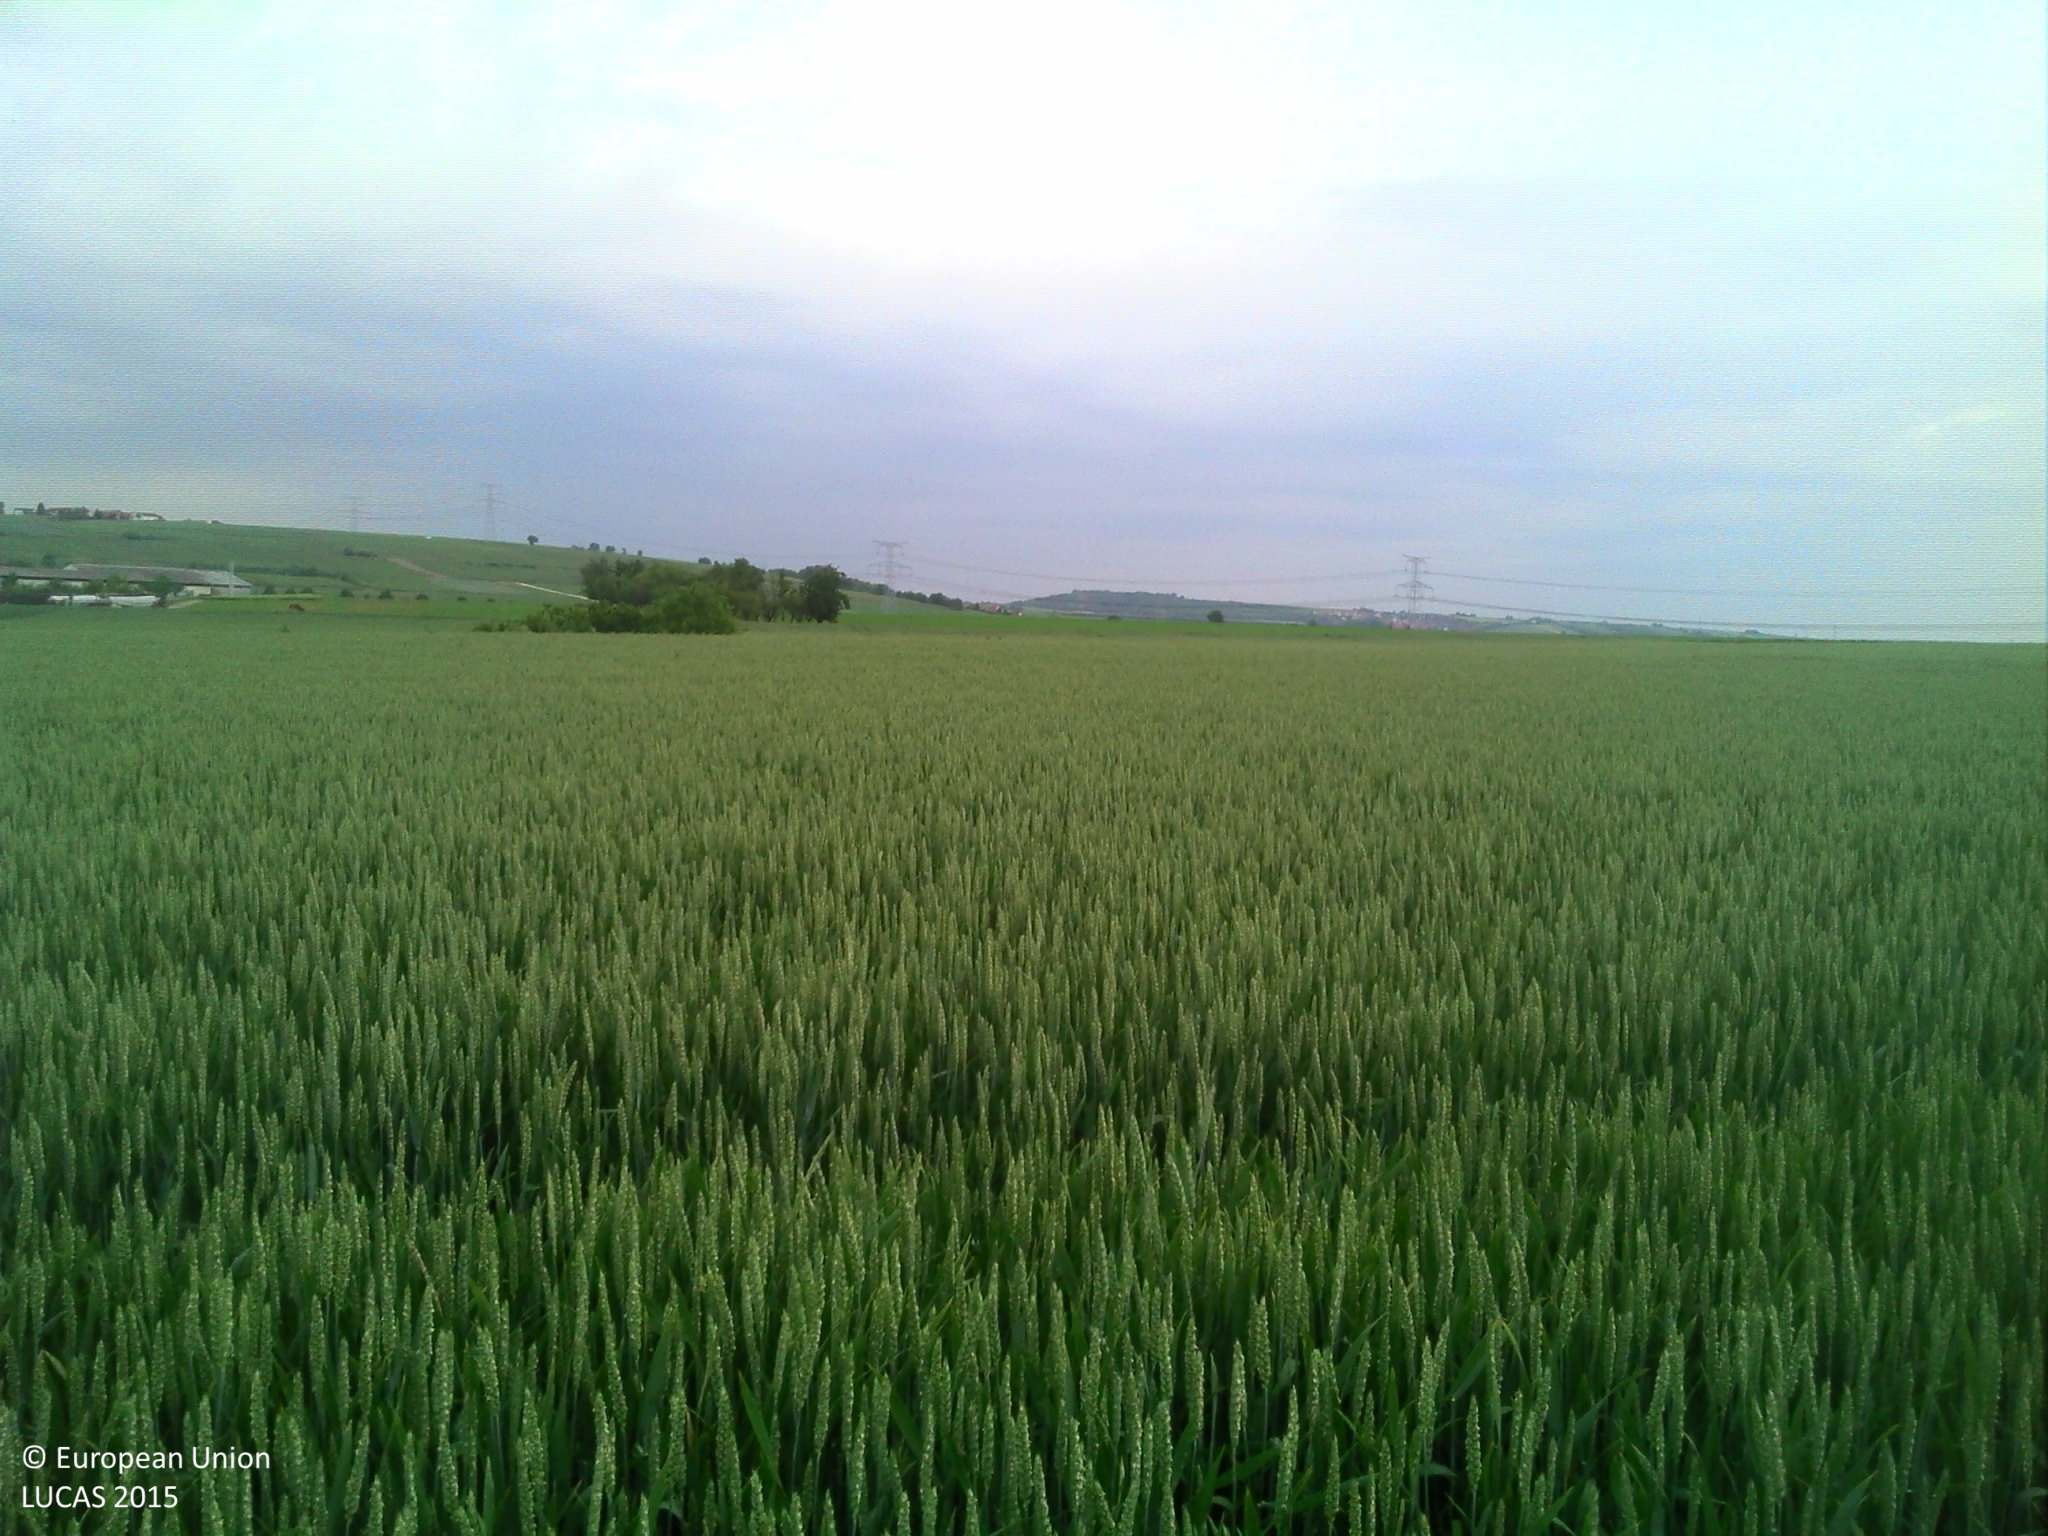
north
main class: Cropland
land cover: Common wheat
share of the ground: > 75 %
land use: Agriculture (excluding fallow land and kitchen gardens)
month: May
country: FR
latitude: 48.6277
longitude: 7.5179
